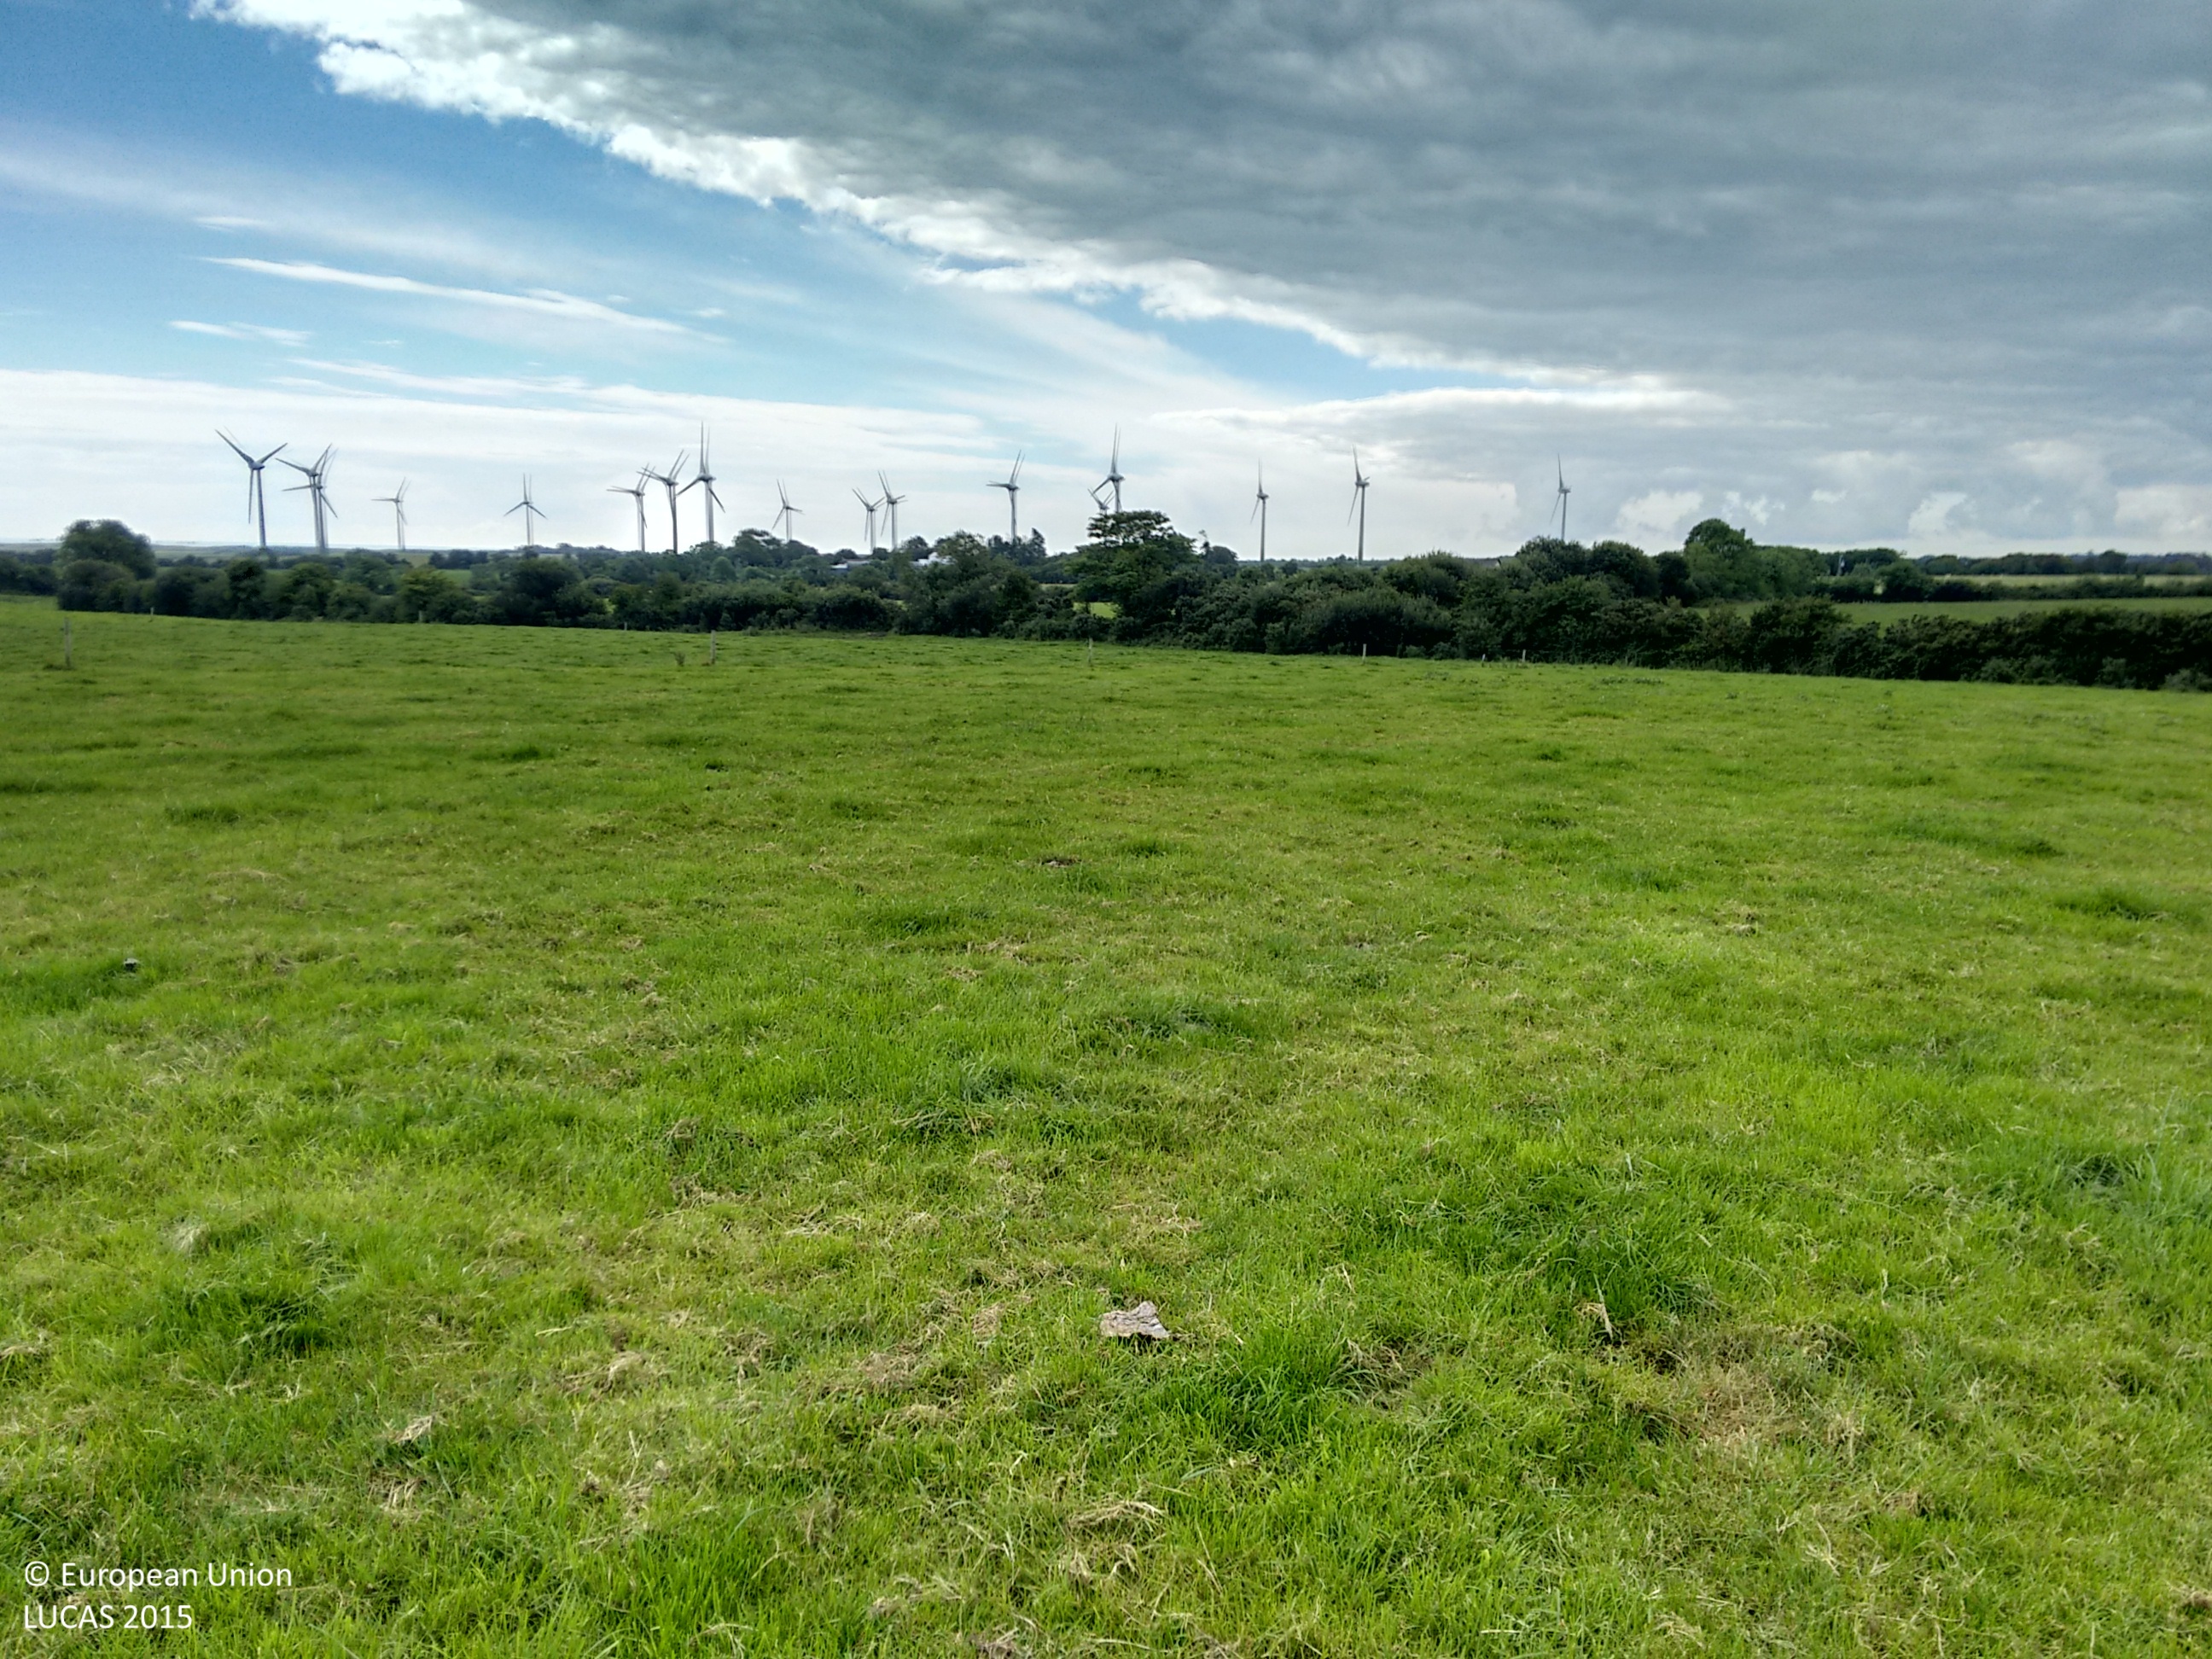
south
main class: Grassland
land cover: Grassland without tree/shrub cover
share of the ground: > 75 %
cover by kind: herbaceous plants 100 %
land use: Agriculture (excluding fallow land and kitchen gardens)
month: August
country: IE
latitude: 52.5520
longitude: -6.2400
